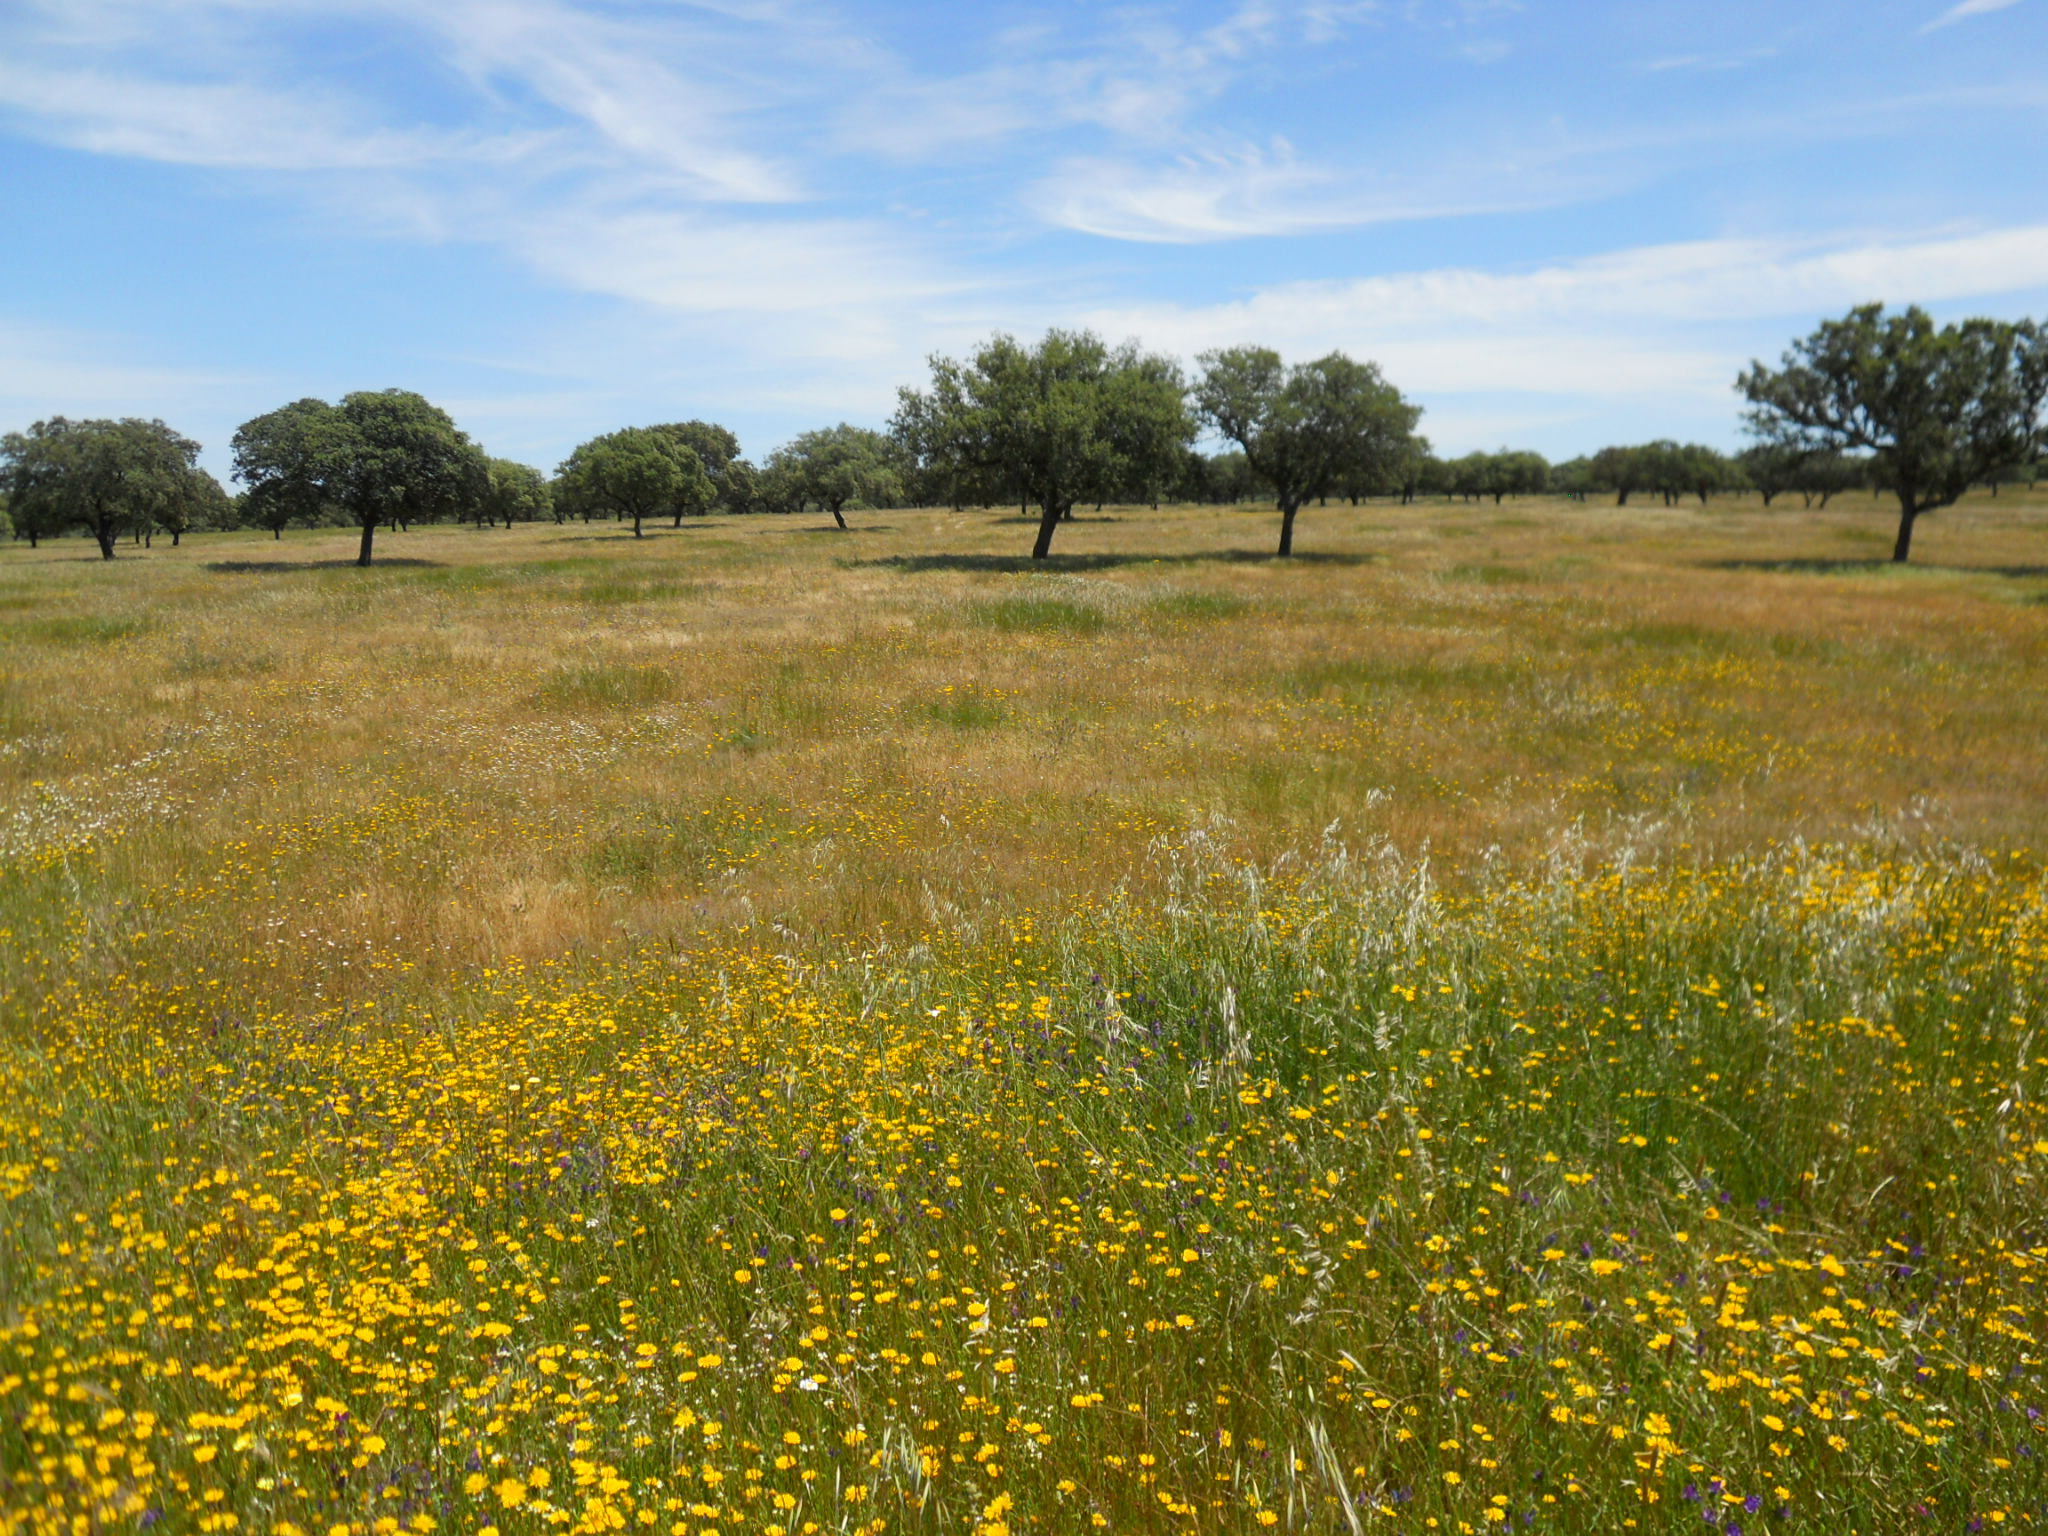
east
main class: Grassland
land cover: Grassland with sparse tree/shrub cover
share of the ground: > 75 %
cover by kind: herbaceous plants 95 %, broadleaved forest trees 5 %
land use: Agriculture (excluding fallow land and kitchen gardens)
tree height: > 5 m
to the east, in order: Grassland with sparse tree/shrub cover; Tracks; Broadleaved woodland; Tracks
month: May
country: ES
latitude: 39.2329
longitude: -6.3634
